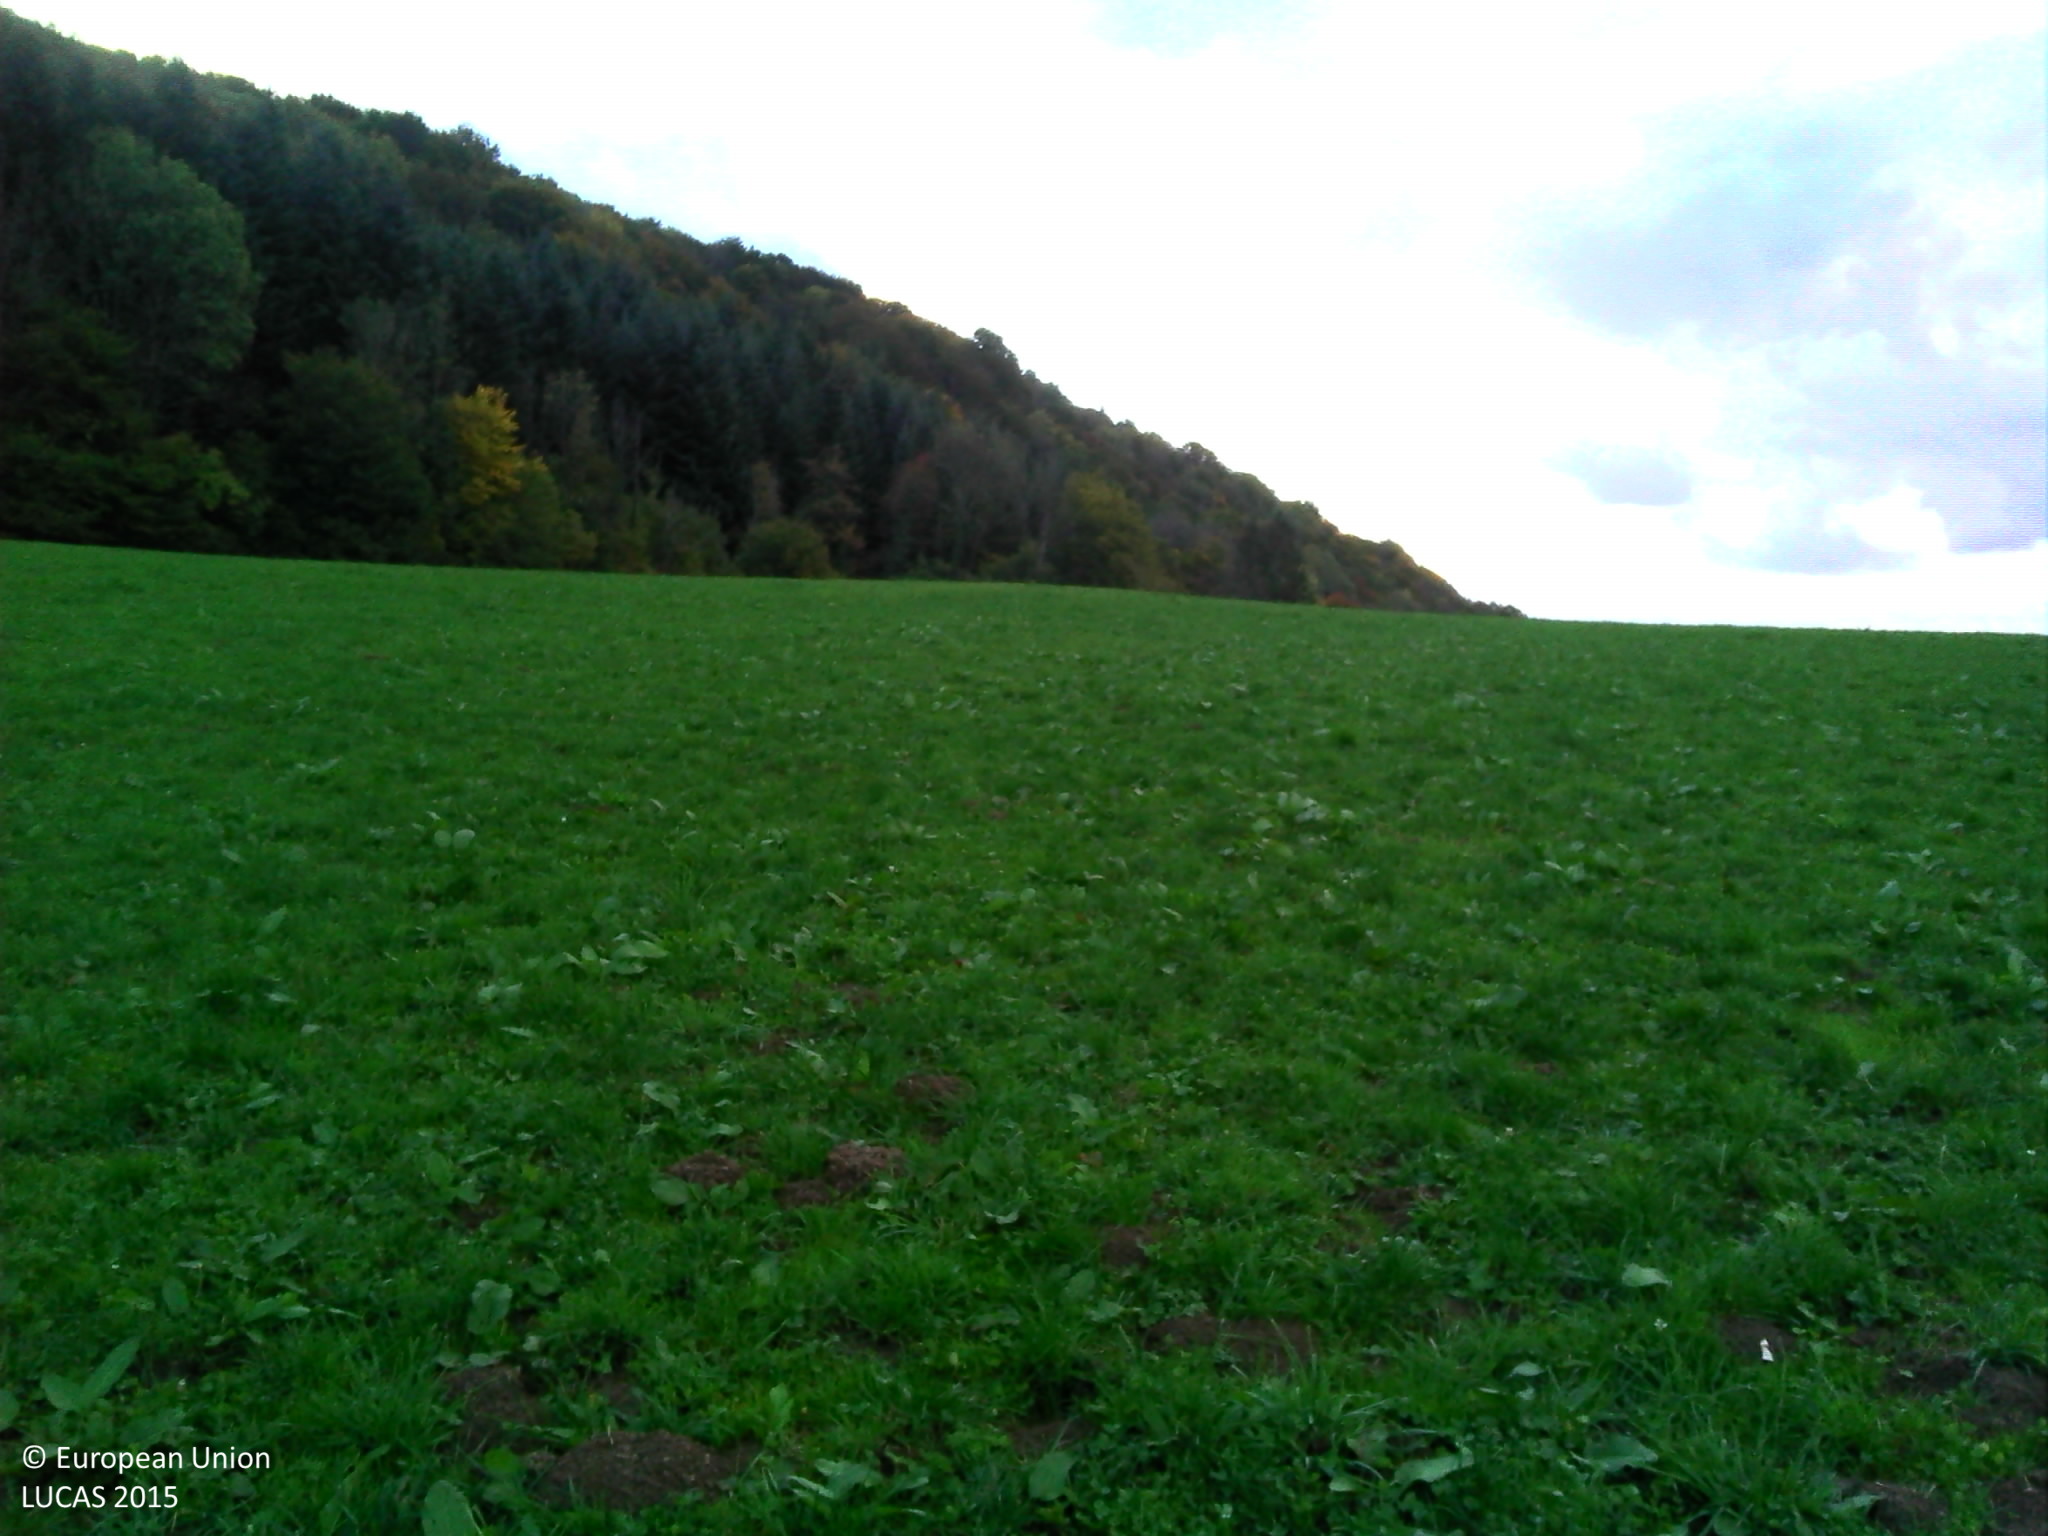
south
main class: Grassland
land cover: Grassland without tree/shrub cover
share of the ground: > 75 %
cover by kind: herbaceous plants 100 %
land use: Agriculture (excluding fallow land and kitchen gardens)
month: October
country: FR
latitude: 47.0891
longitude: 6.0369
